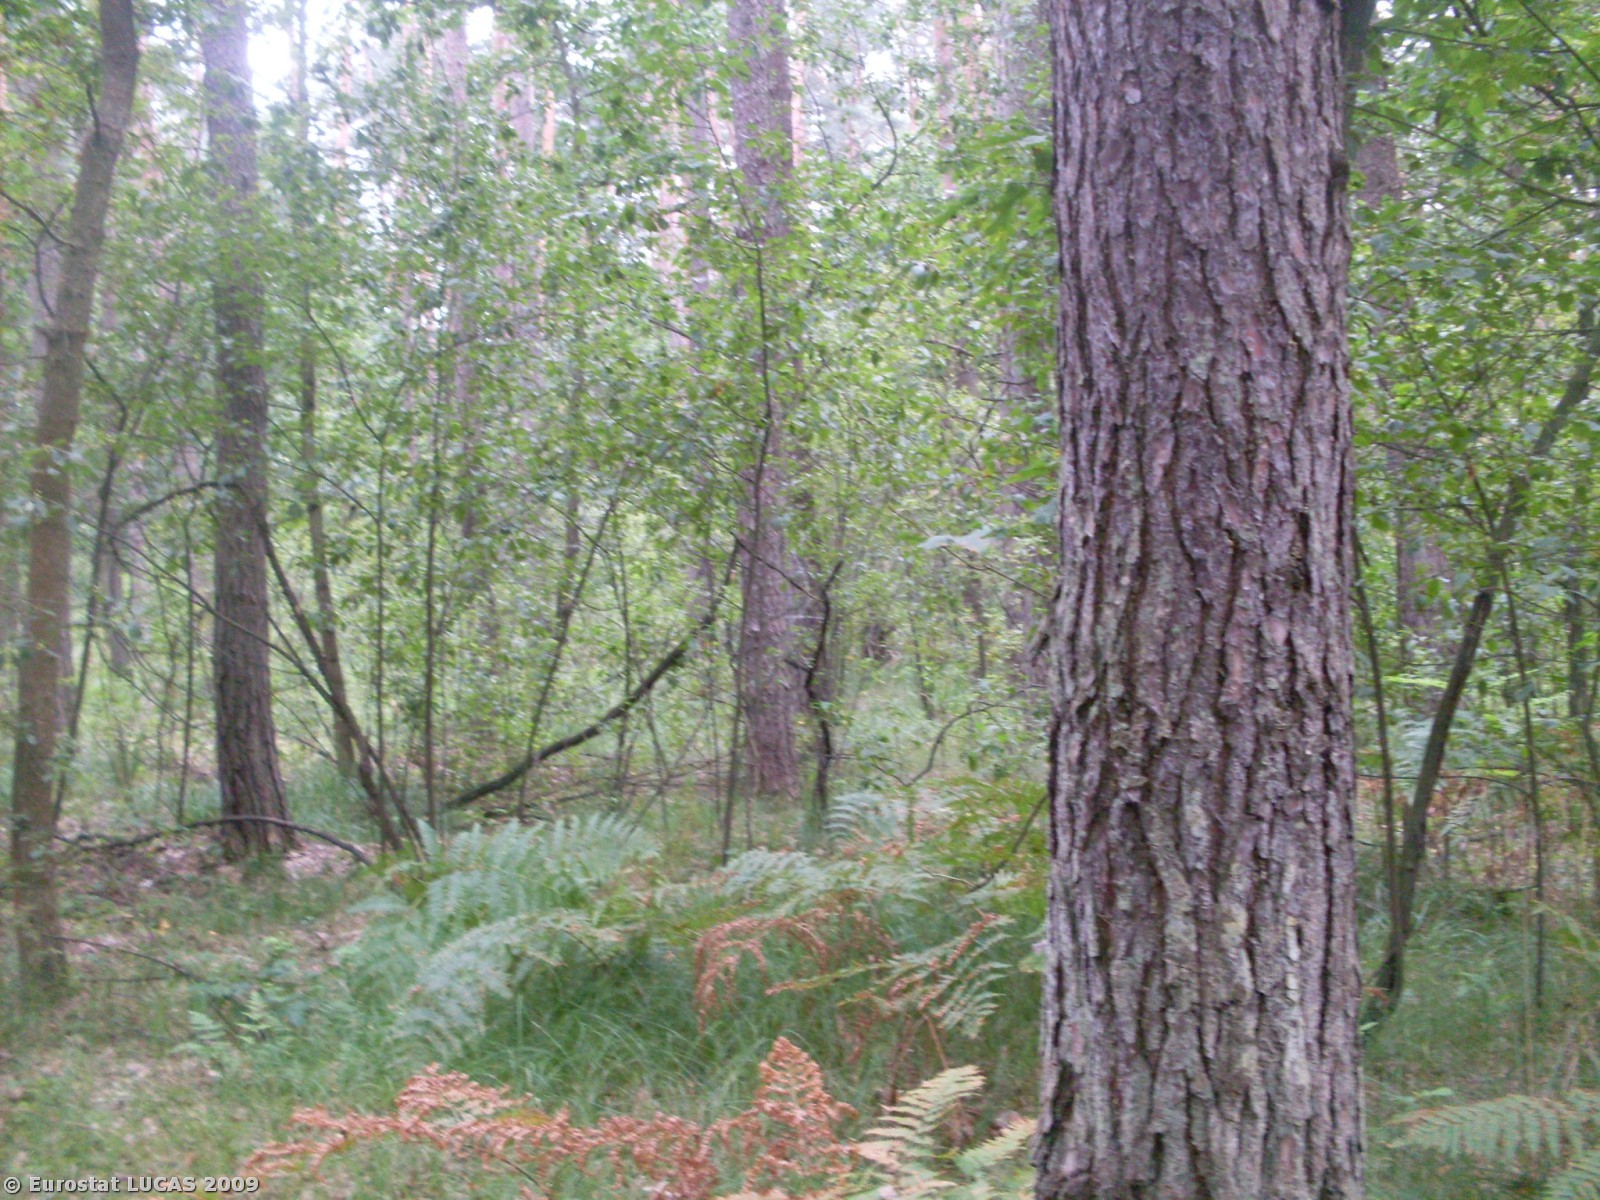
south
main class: Woodland
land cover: Coniferous woodland
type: hemiboreal forest and nemoral coniferous forest and mixed broadleaved-coniferous forest
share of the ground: > 75 %
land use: Forestry
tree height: > 5 m
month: August
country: PL
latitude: 50.0682
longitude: 20.6150
